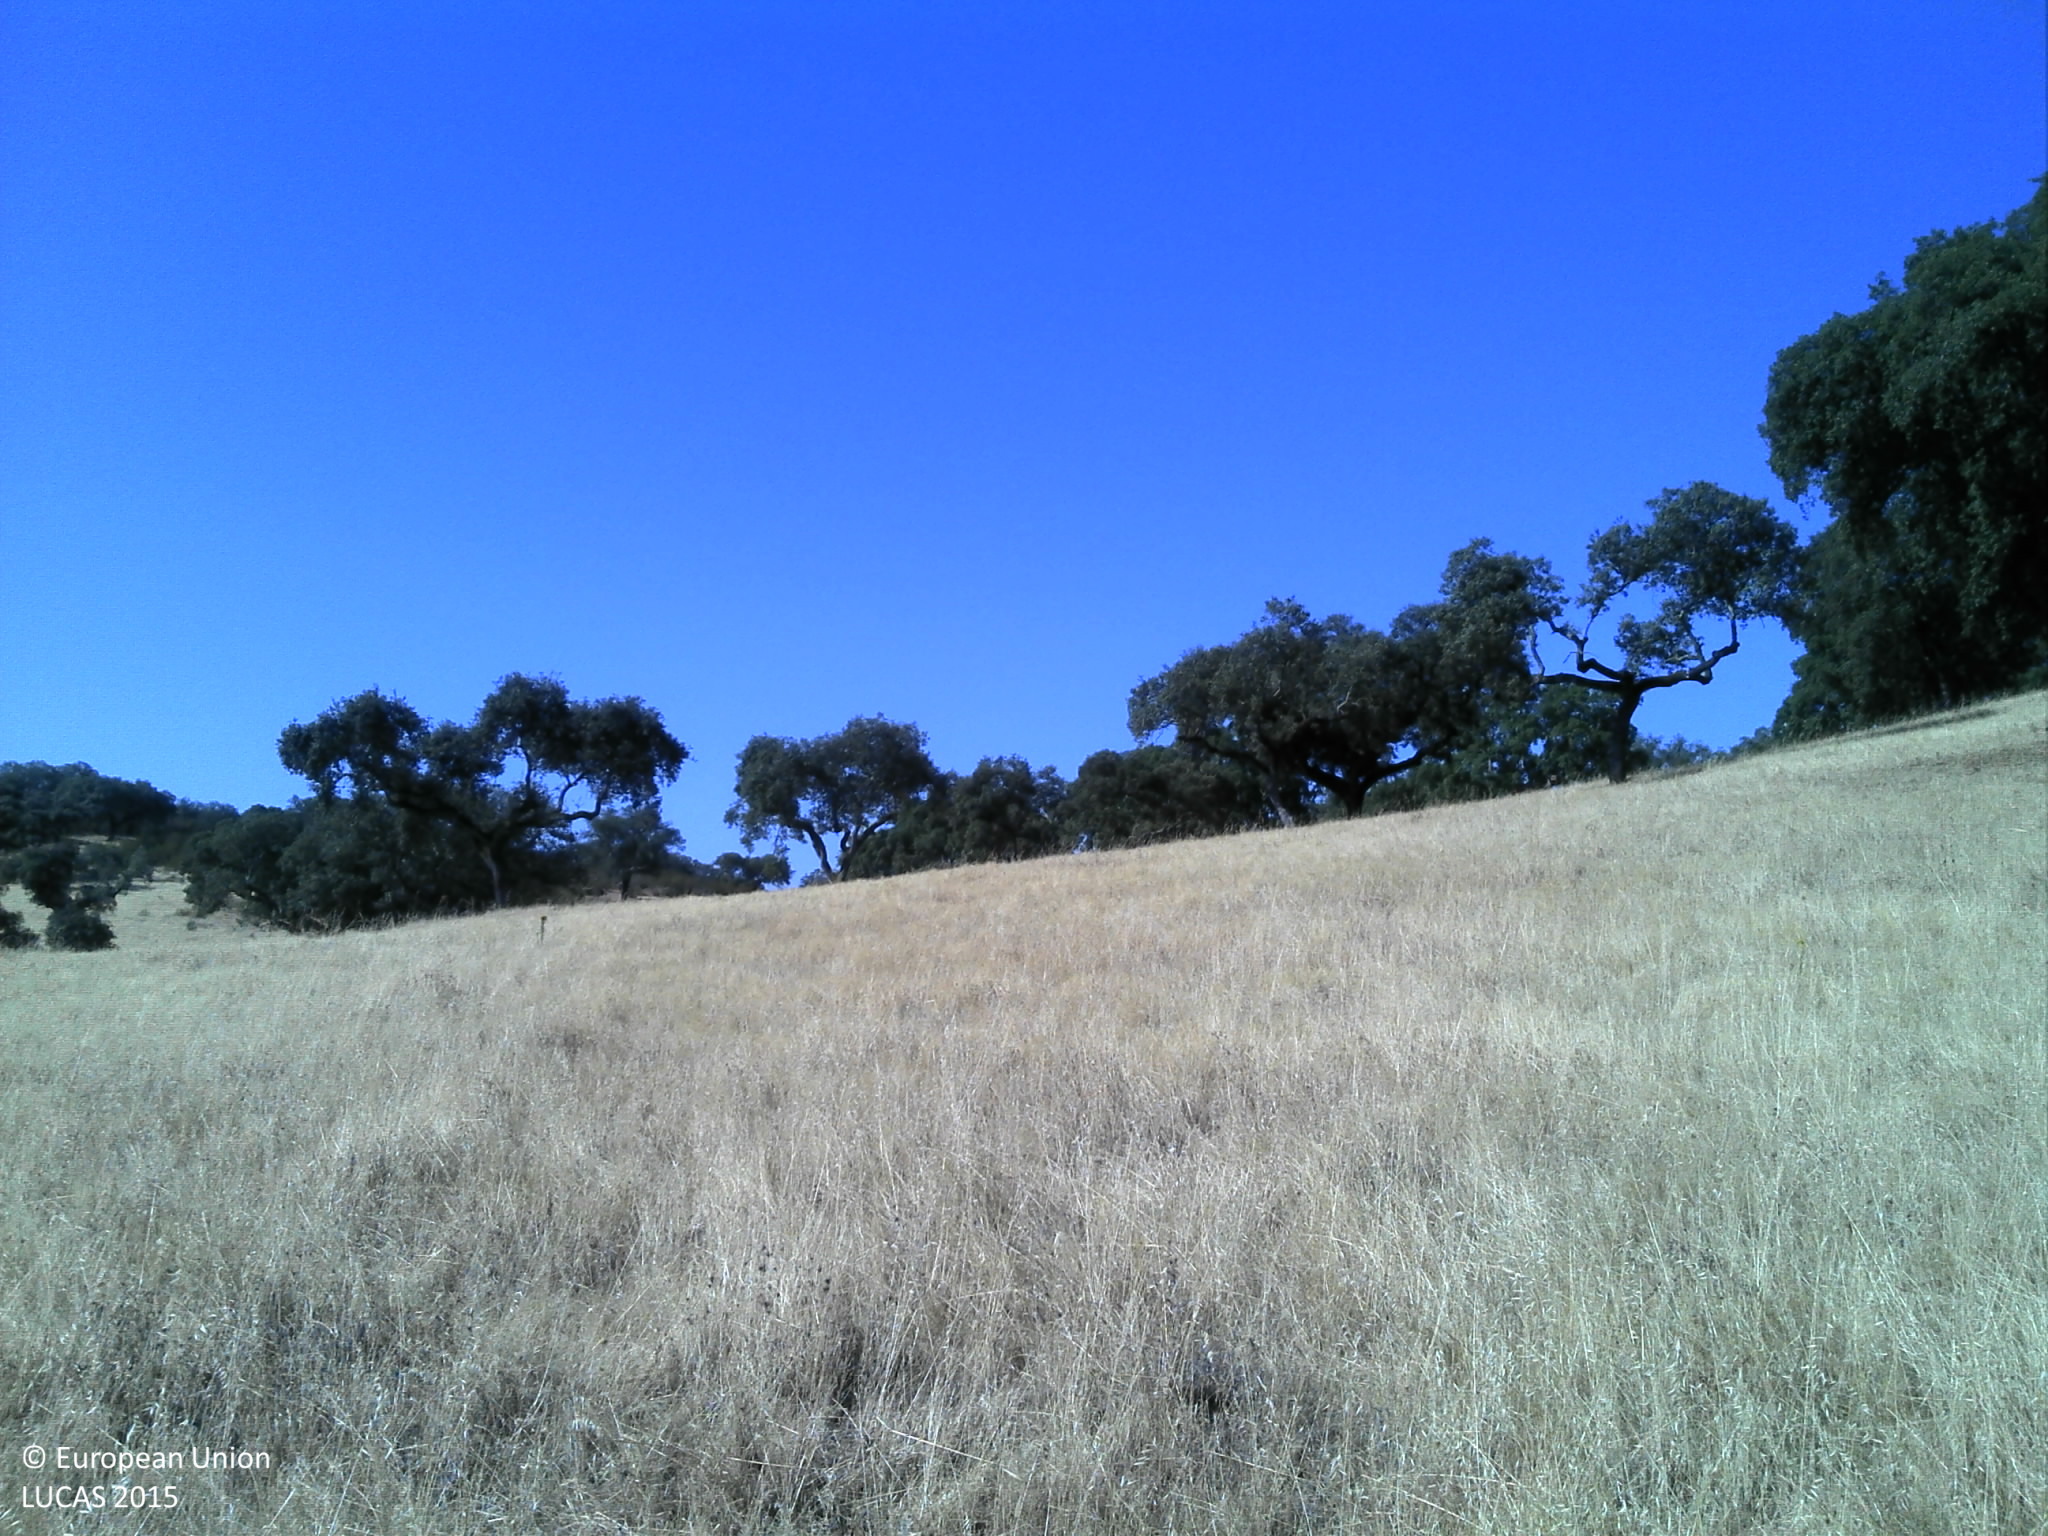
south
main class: Grassland
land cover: Grassland without tree/shrub cover
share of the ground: 50 - 75 %
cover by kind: herbaceous plants 75 %, unconsolidated bare surface 25 %
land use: Agriculture (excluding fallow land and kitchen gardens)
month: July
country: PT
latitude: 38.6443
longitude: -7.2951
